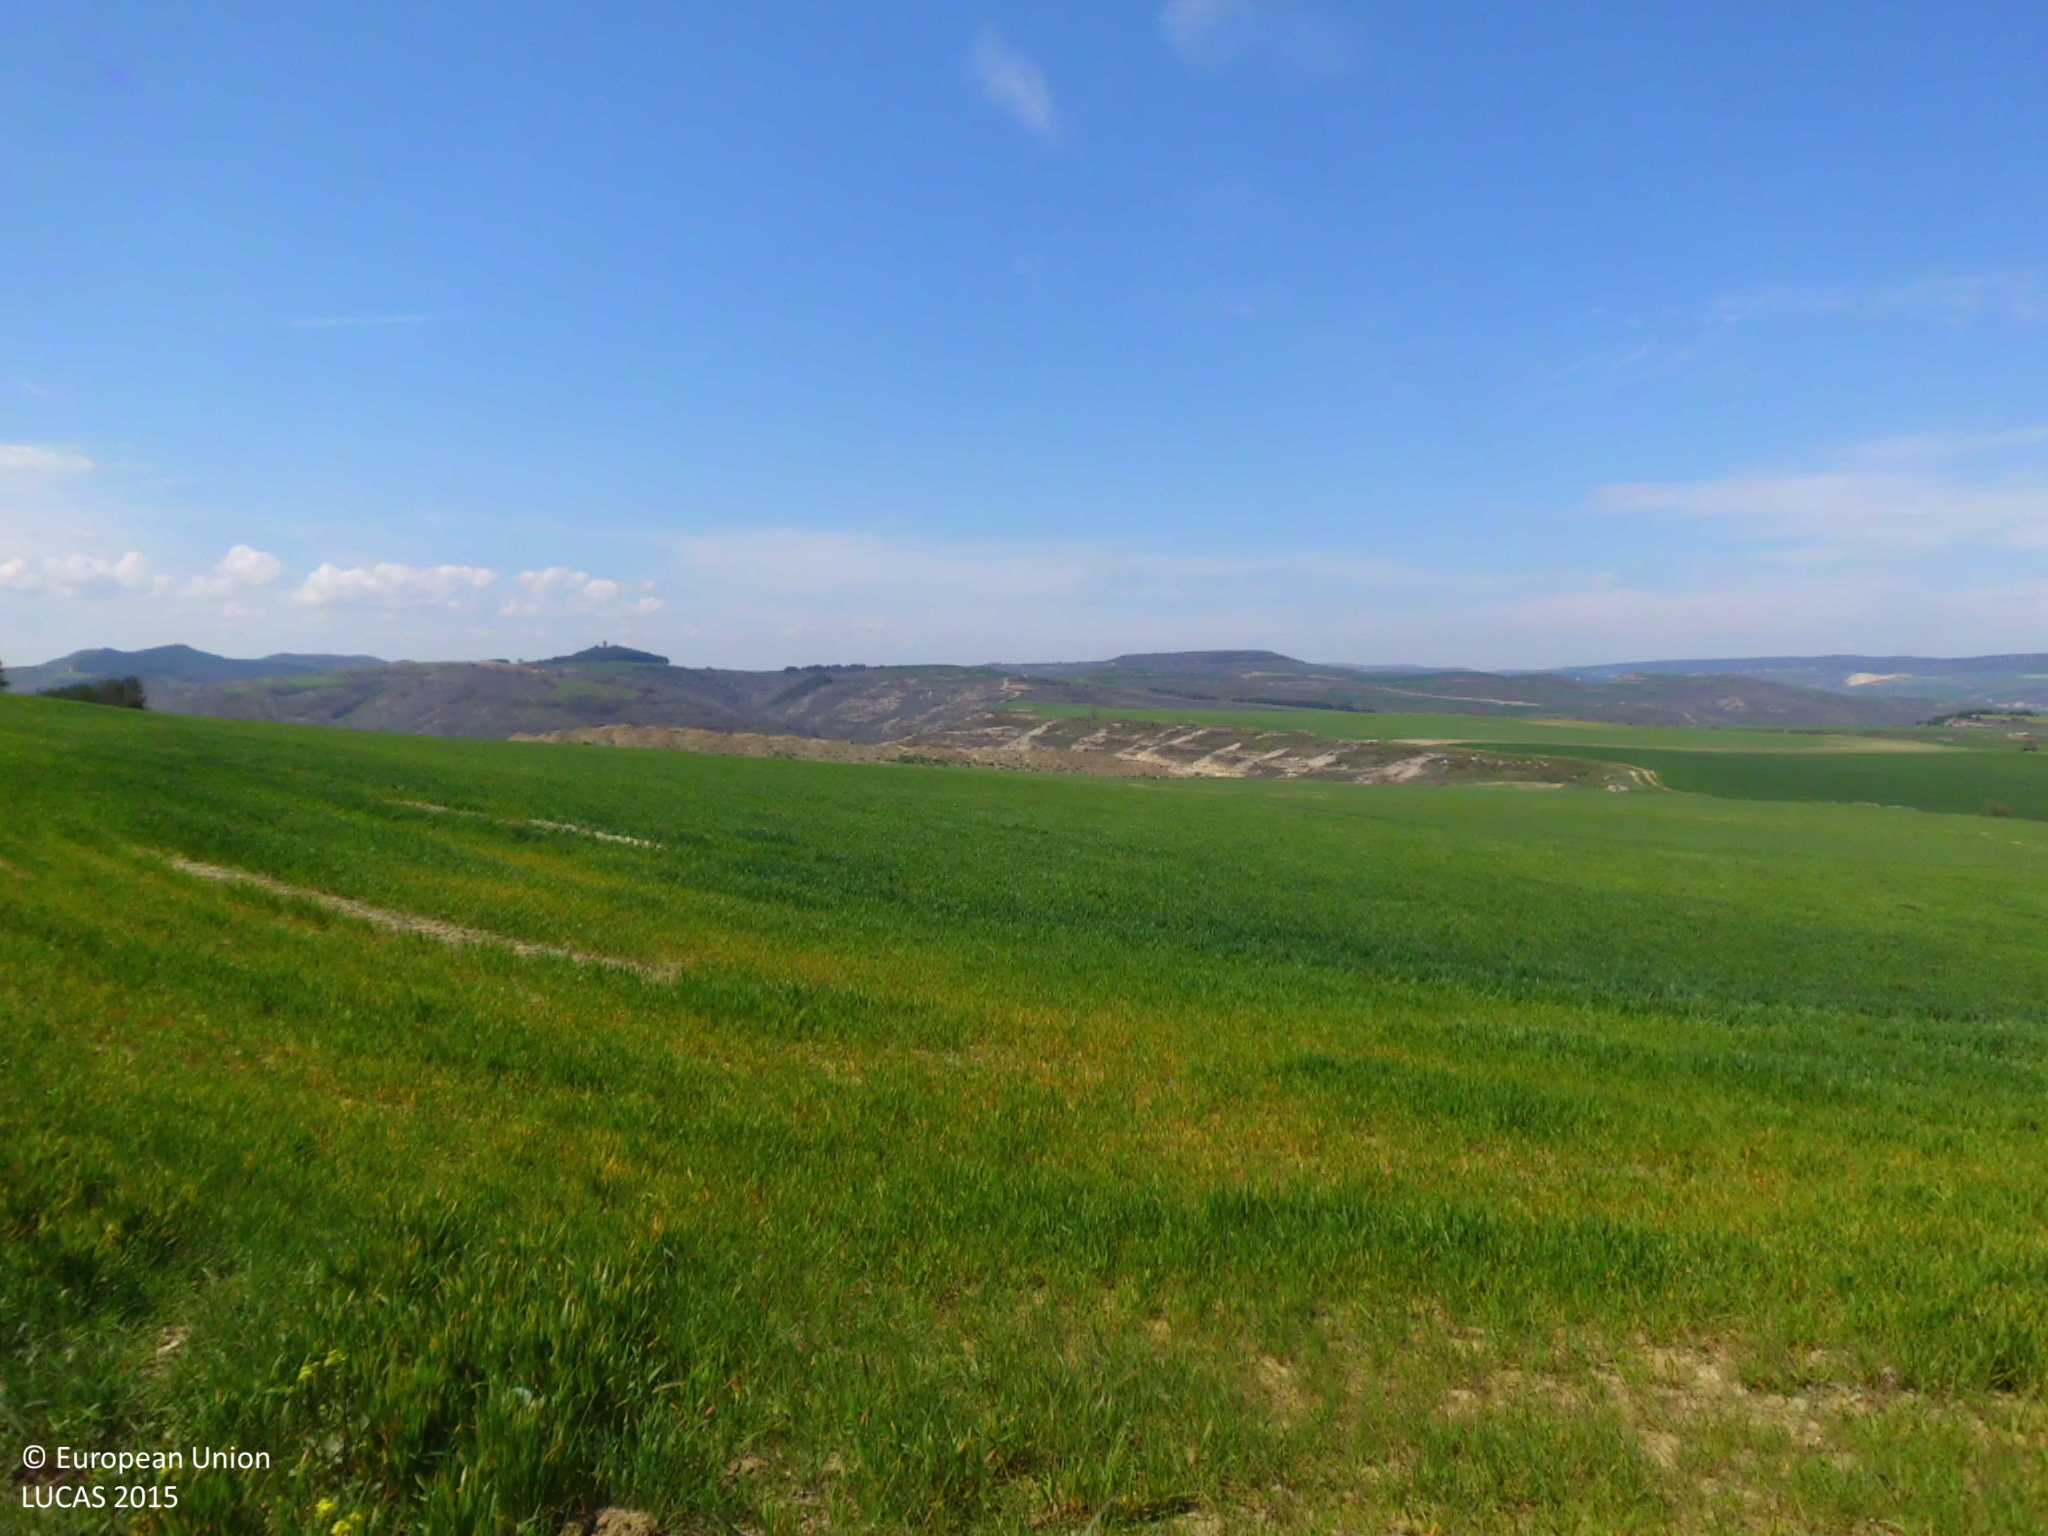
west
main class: Grassland
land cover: Grassland with sparse tree/shrub cover
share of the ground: > 75 %
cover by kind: herbaceous plants 90 %, broadleaved forest trees 5 %, shrubs 5 %
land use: Abandoned areas
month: April
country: ES
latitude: 42.4639
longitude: -3.3245
